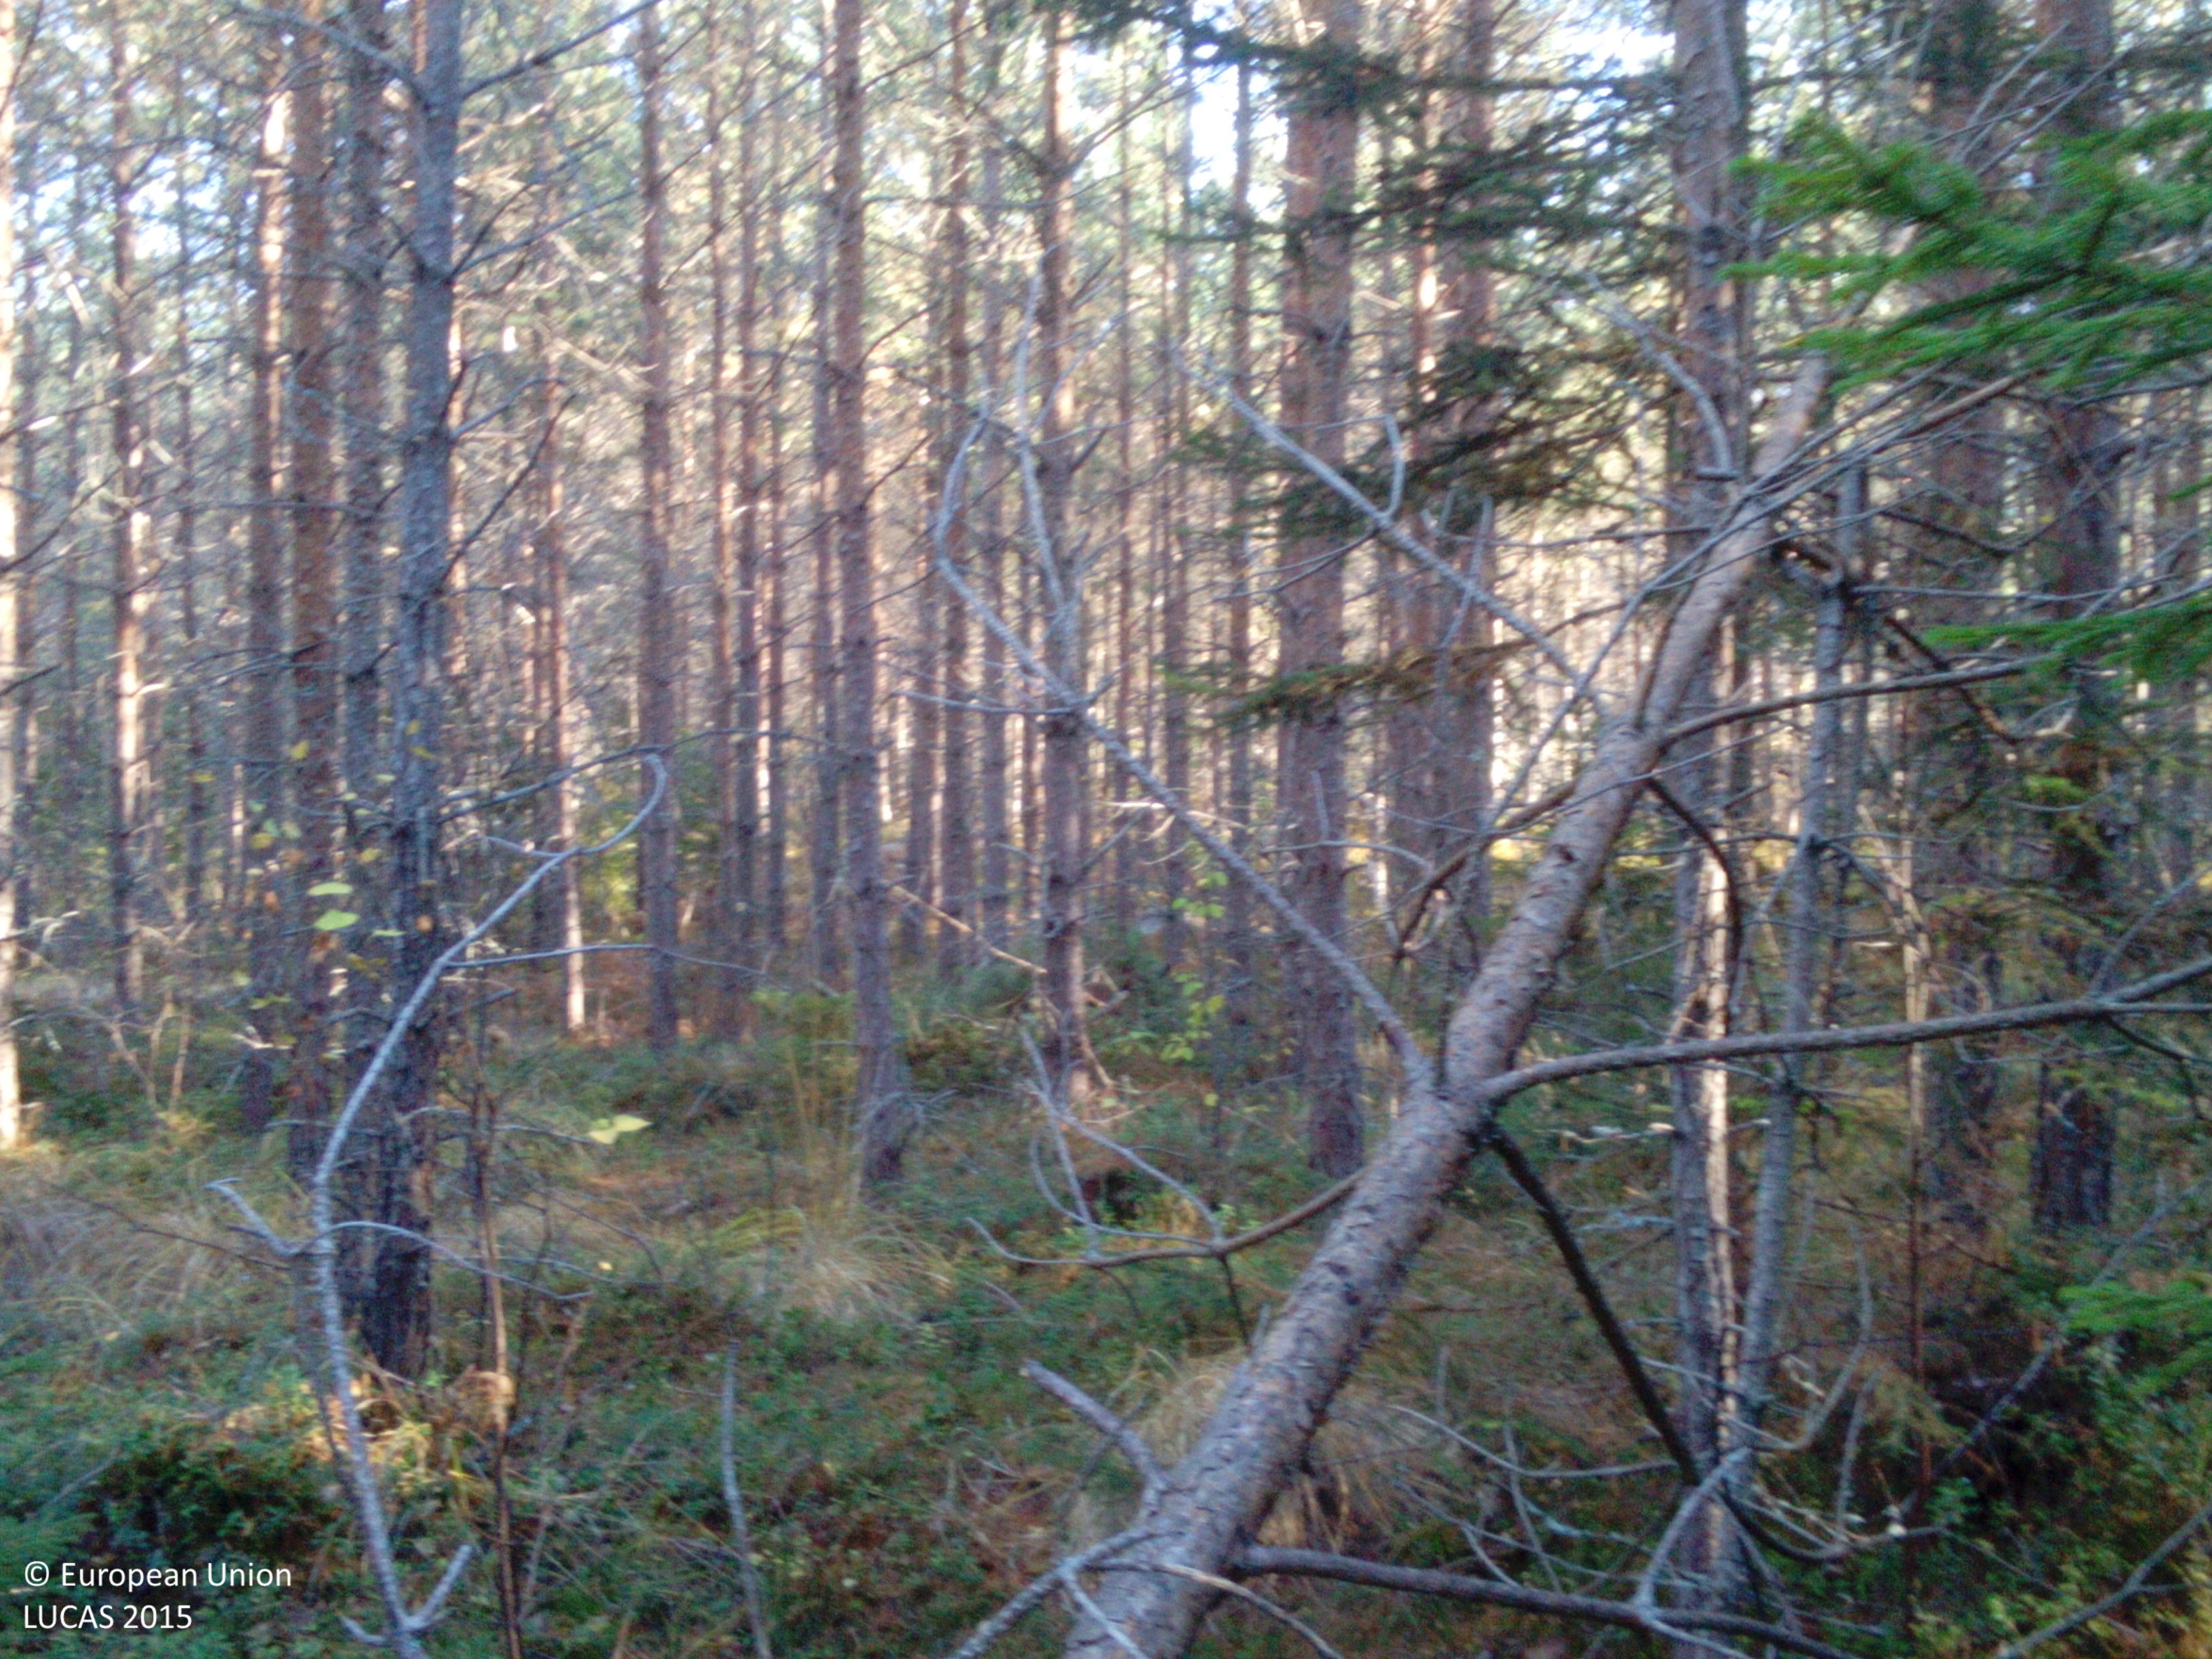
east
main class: Woodland
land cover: Other coniferous woodland
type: boreal forest
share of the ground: > 75 %
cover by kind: coniferous forest trees 85 %, herbaceous plants 10 %, lichens and mosses 5 %
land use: Forestry
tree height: > 5 m
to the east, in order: Other coniferous woodland; Pine dominated coniferous woodland; Lichens and moss; Pine dominated coniferous woodland; Lichens and moss; Pine dominated coniferous woodland; Ditches and canals; Pine dominated coniferous woodland
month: October
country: SE
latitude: 59.2020
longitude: 16.4548
